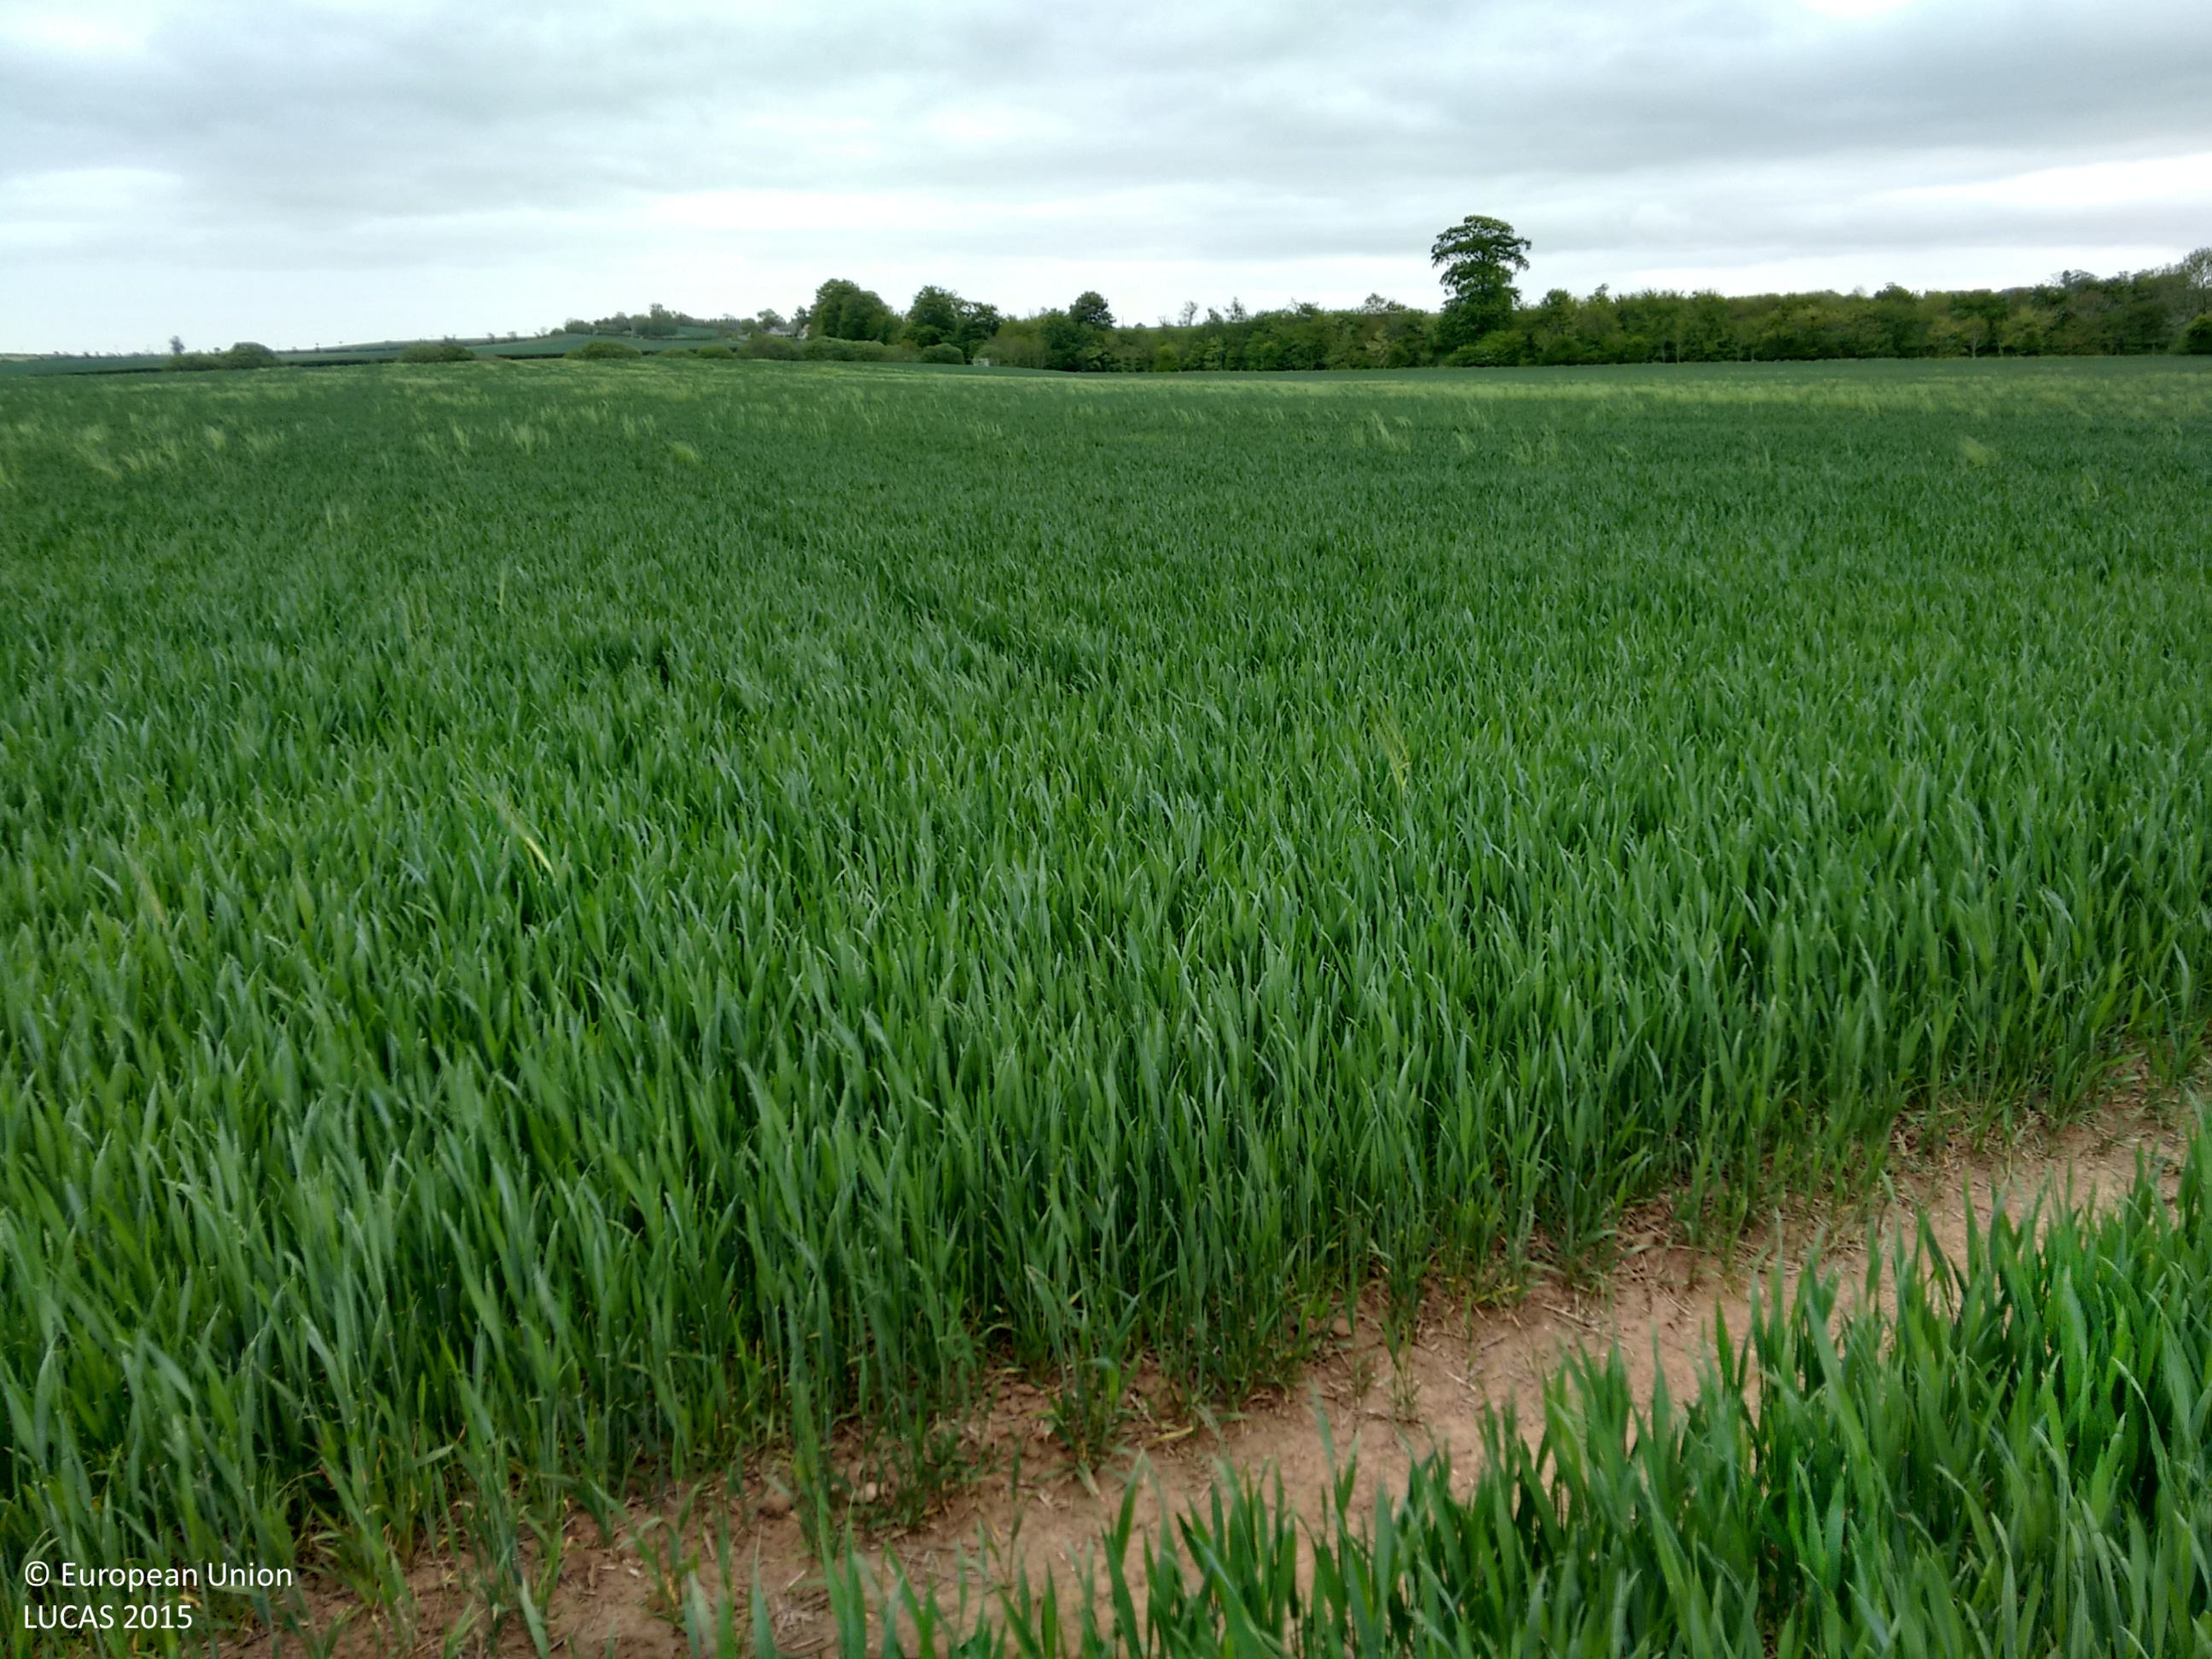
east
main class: Cropland
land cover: Common wheat
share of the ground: > 75 %
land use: Agriculture (excluding fallow land and kitchen gardens)
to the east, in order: Common wheat
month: May
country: GB
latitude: 55.7445
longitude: -2.2422
